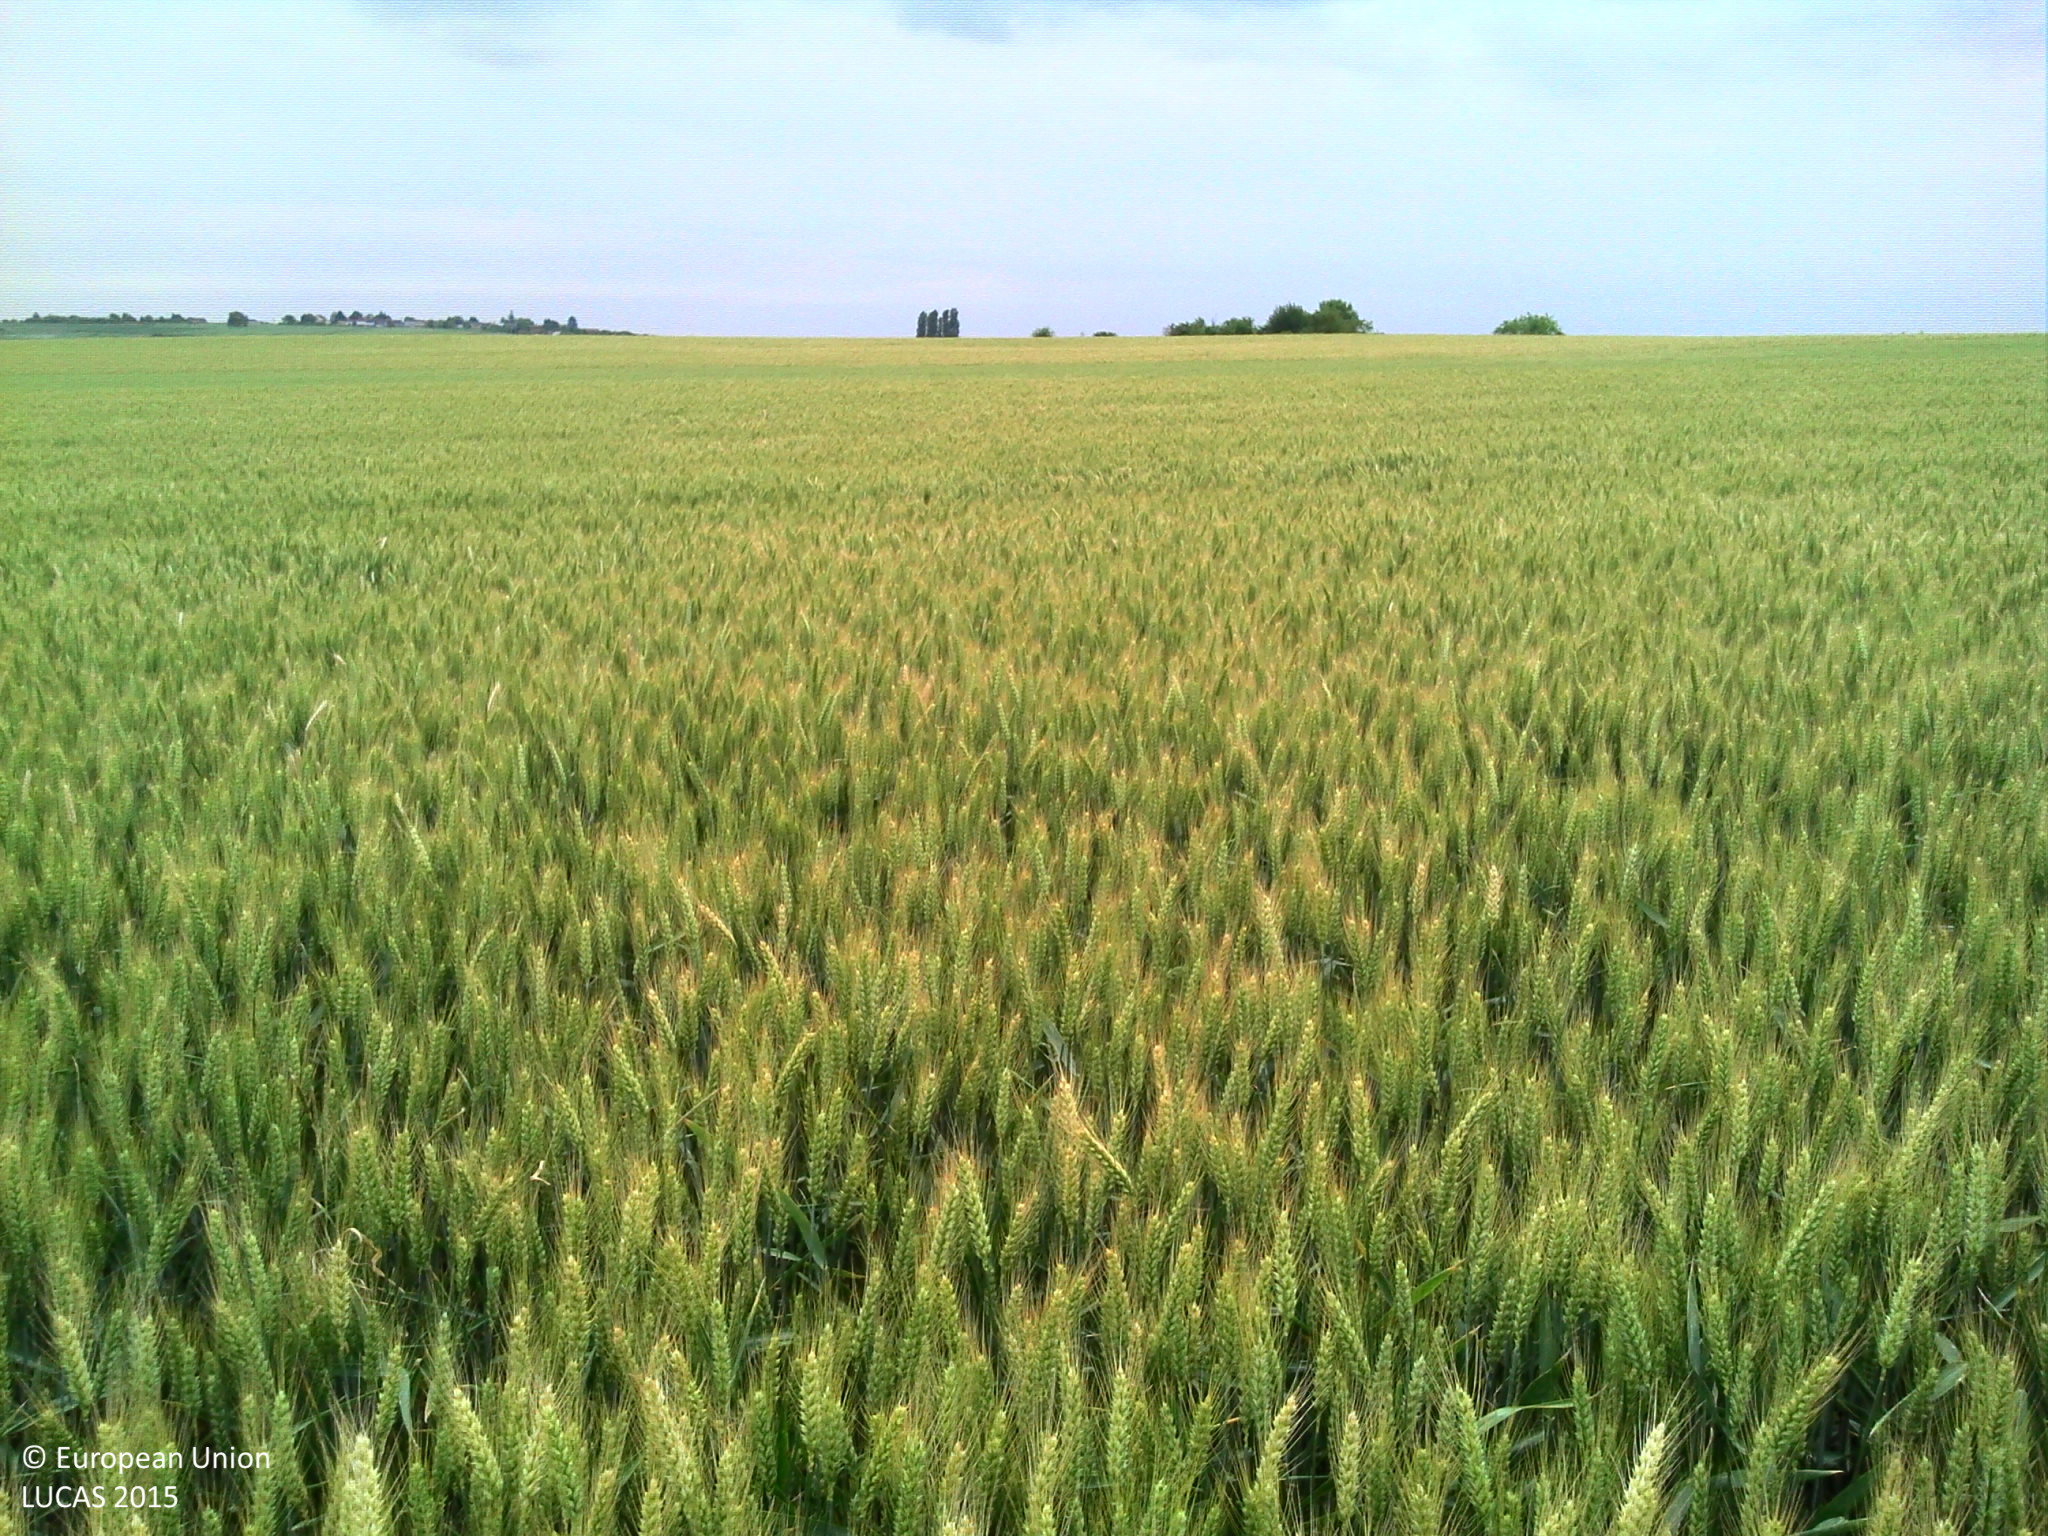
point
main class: Cropland
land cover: Common wheat
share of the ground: > 75 %
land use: Agriculture (excluding fallow land and kitchen gardens)
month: June
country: FR
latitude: 46.8643
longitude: 0.2321
